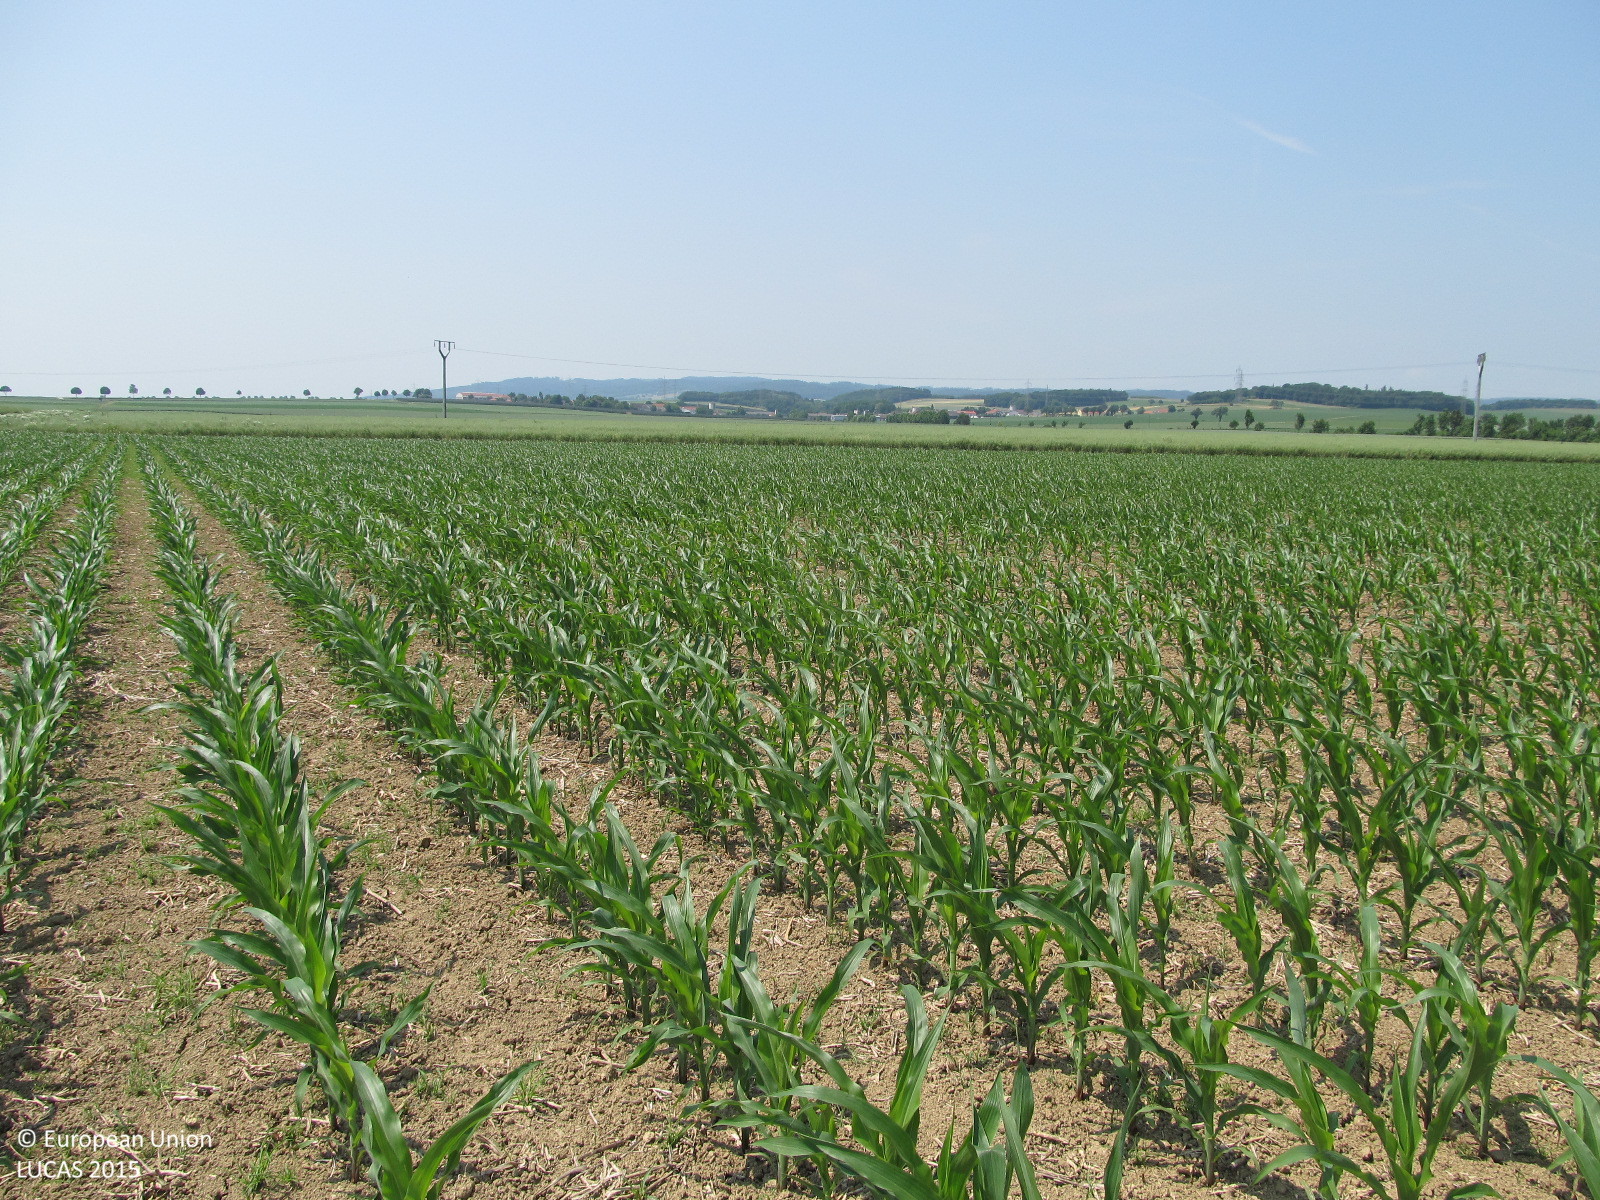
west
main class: Cropland
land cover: Maize
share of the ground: 25 - 50 %
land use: Agriculture (excluding fallow land and kitchen gardens)
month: June
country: AT
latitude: 48.2427
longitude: 15.6179
